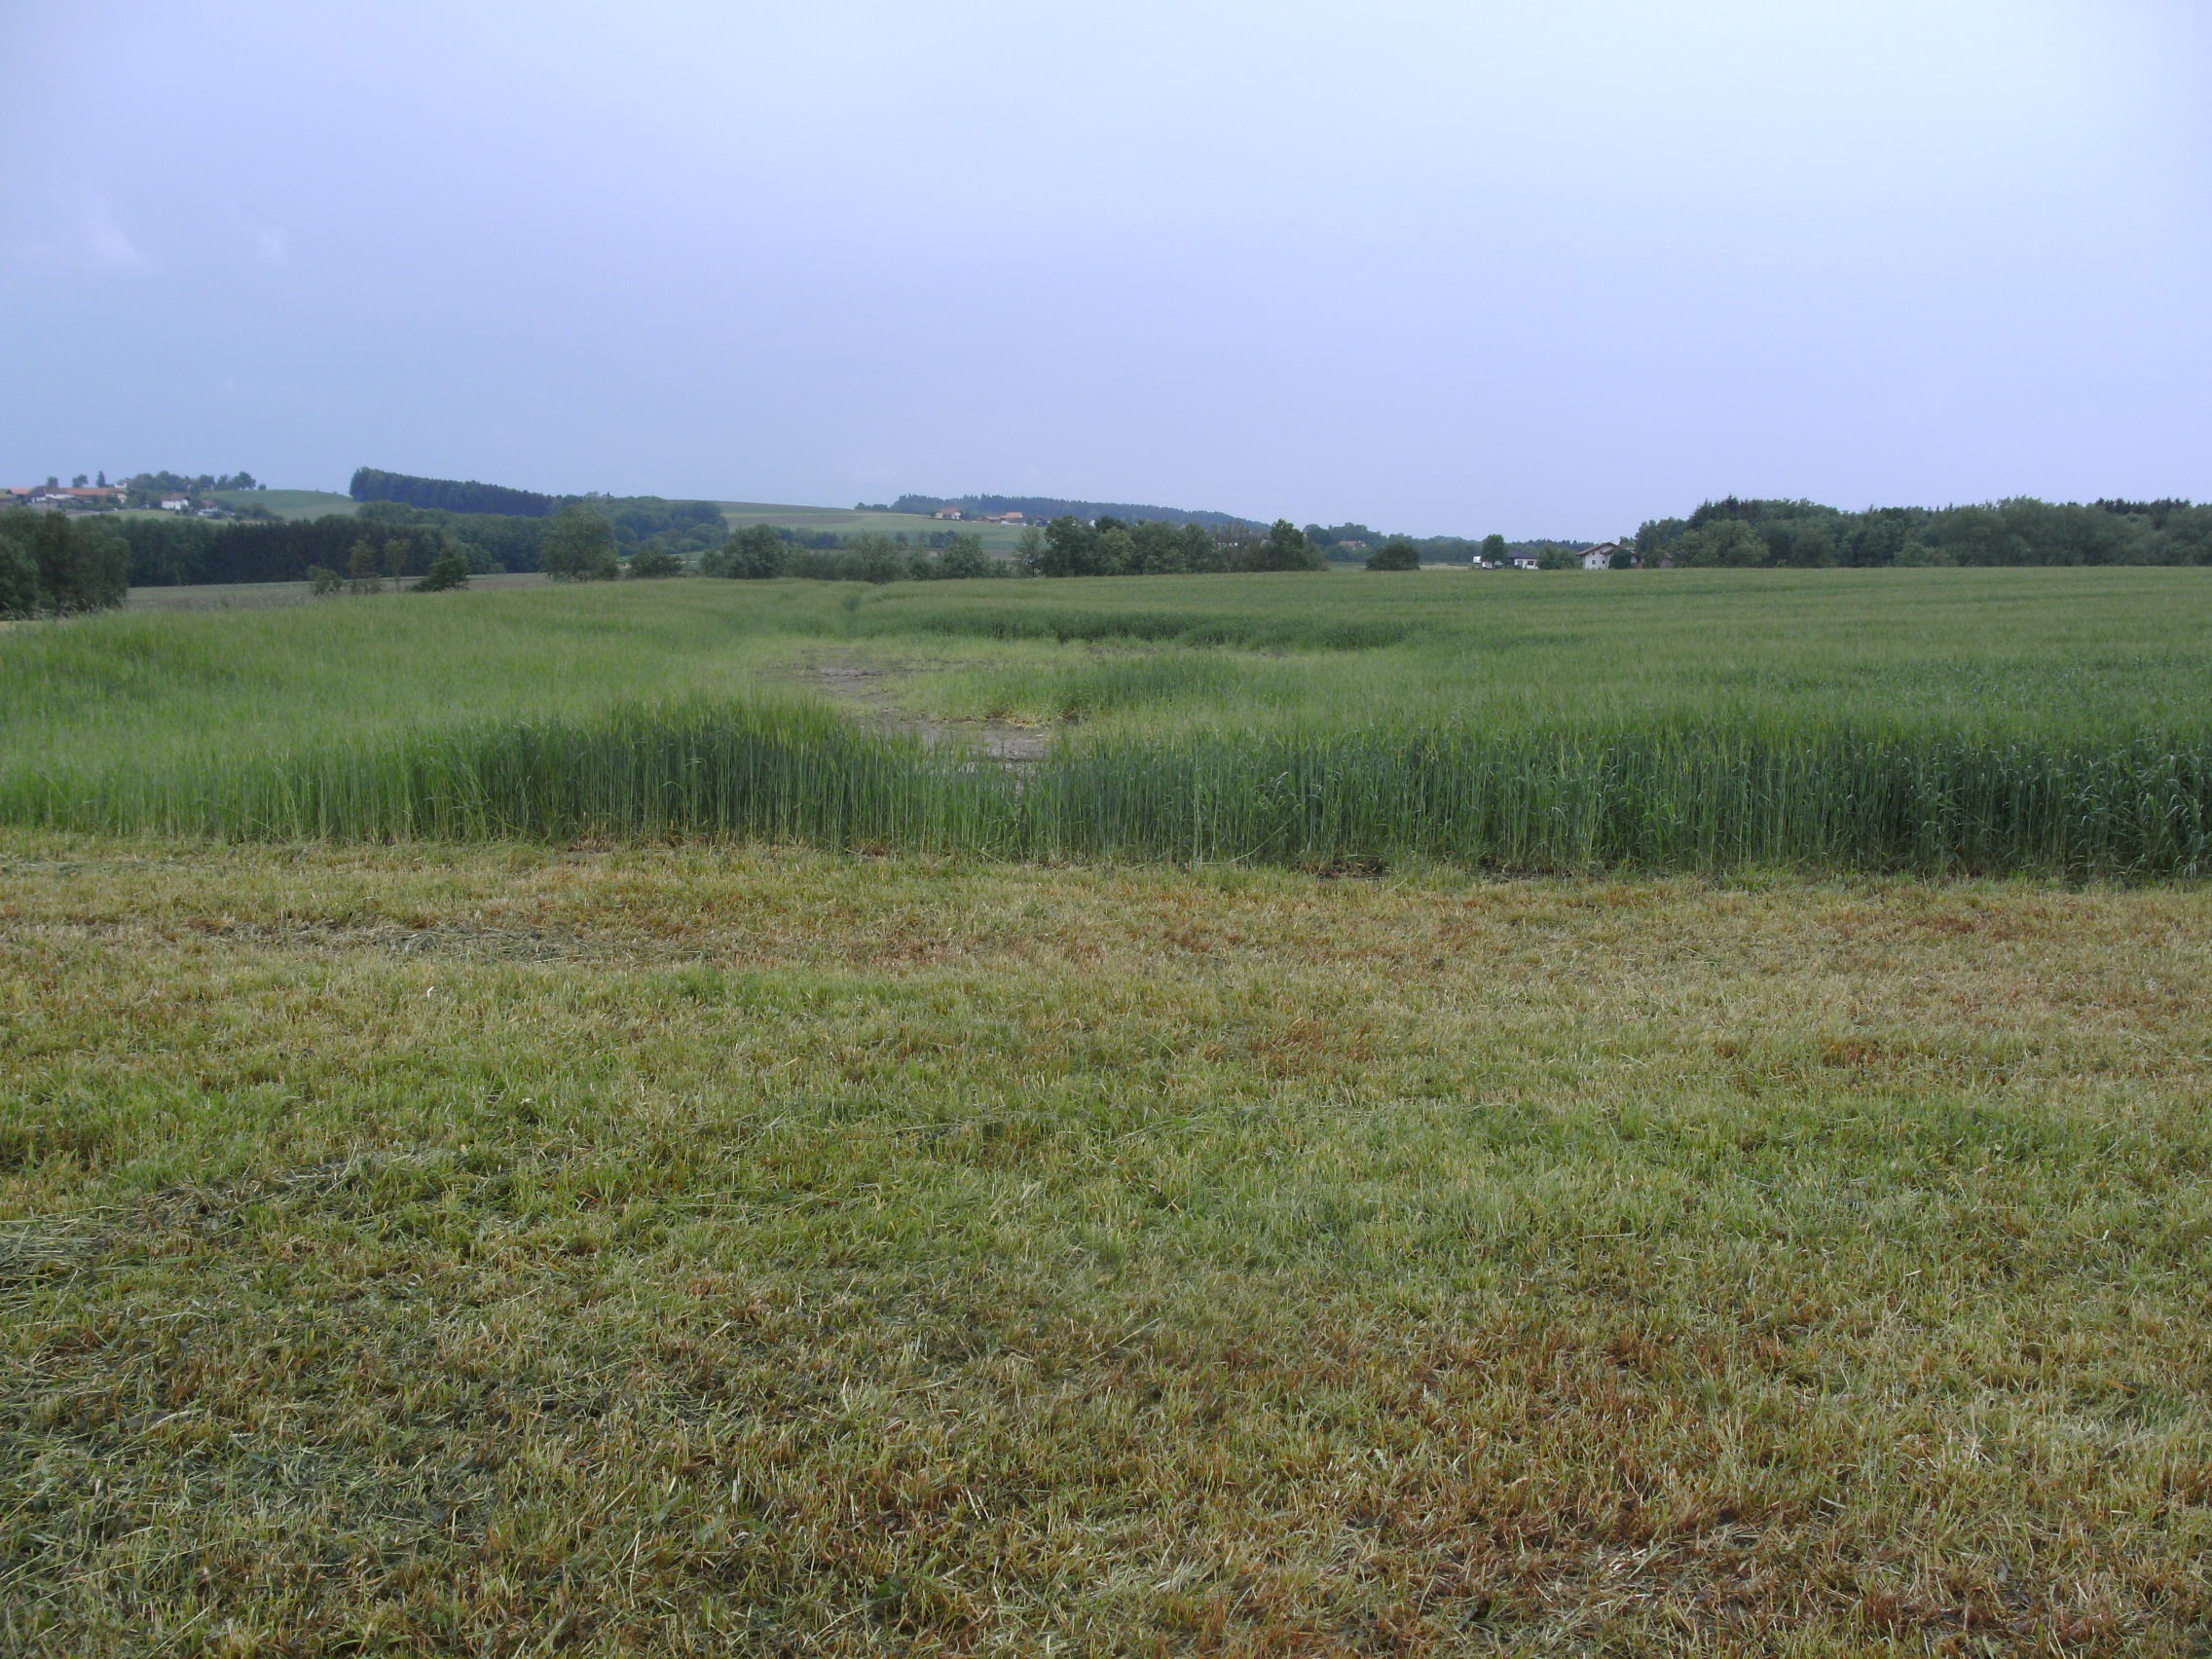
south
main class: Grassland
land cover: Grassland without tree/shrub cover
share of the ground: > 75 %
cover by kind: herbaceous plants 100 %
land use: Agriculture (excluding fallow land and kitchen gardens)
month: May
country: AT
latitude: 48.3663
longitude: 13.4955
